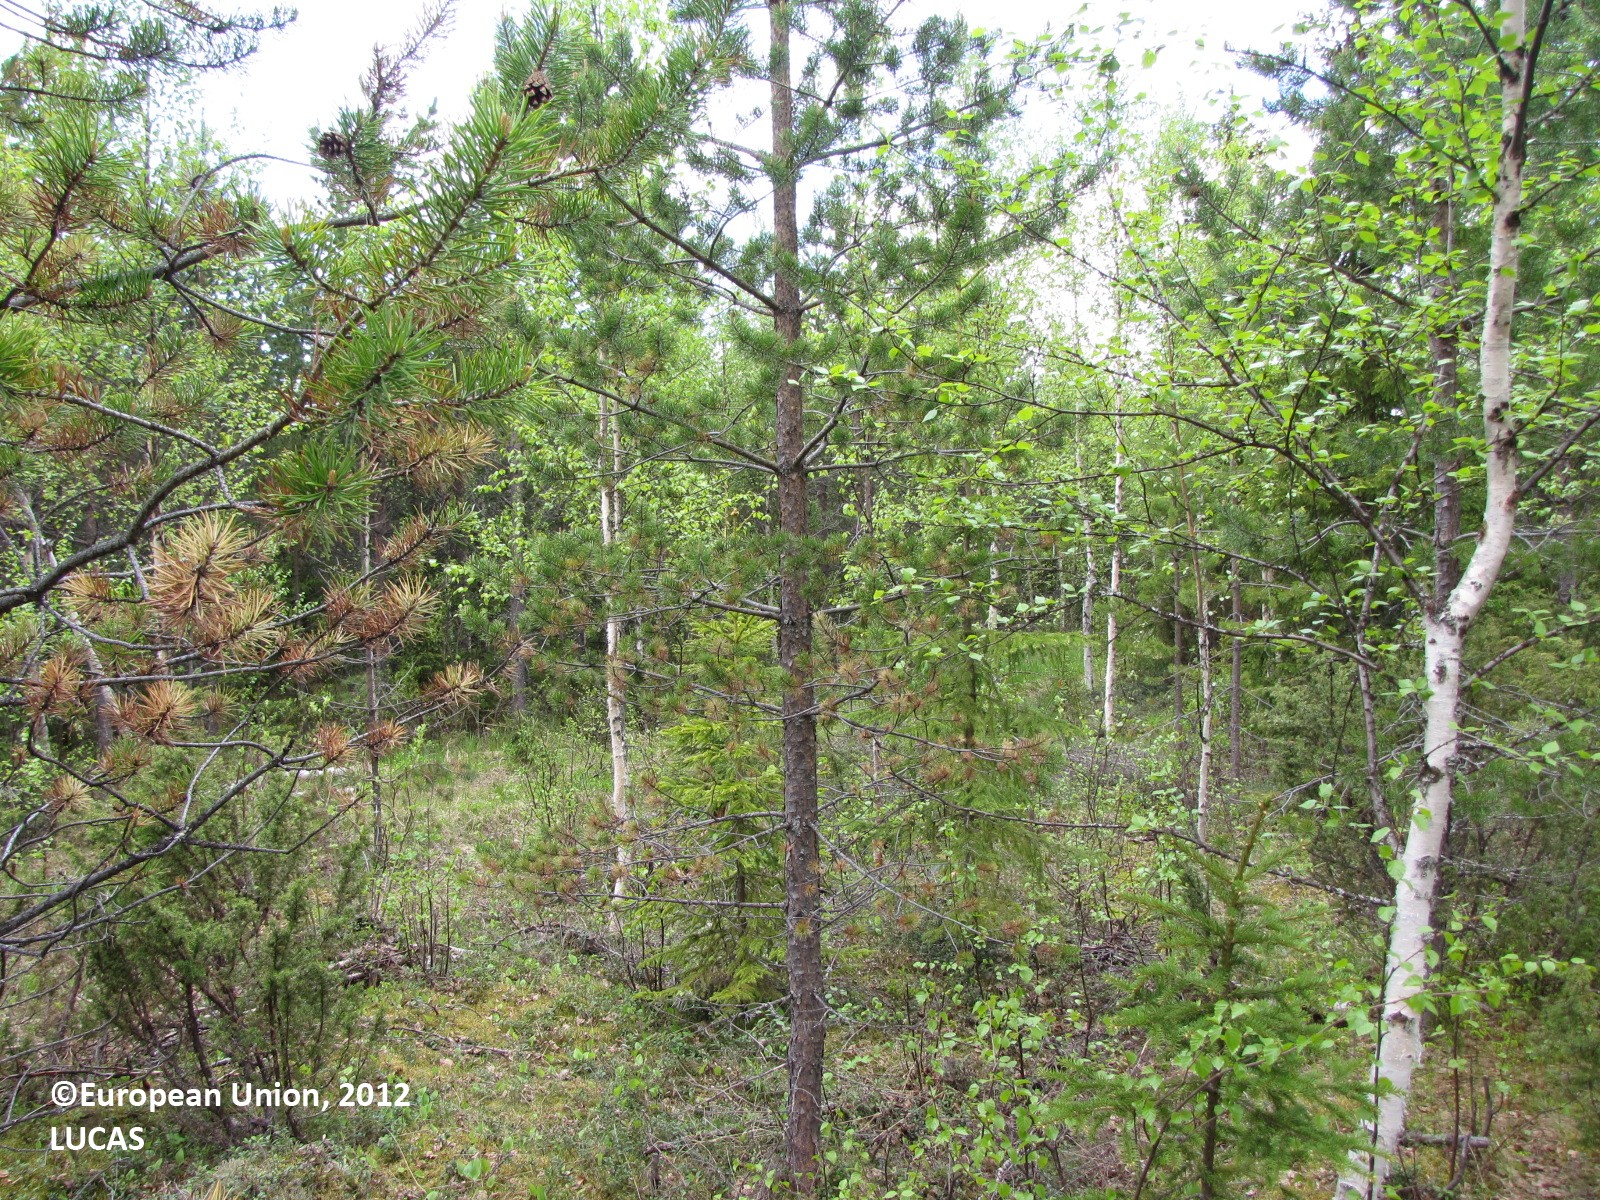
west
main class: Woodland
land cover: Other coniferous woodland
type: boreal forest
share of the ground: 25 - 50 %
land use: Forestry
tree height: > 5 m
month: June
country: FI
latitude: 65.8525
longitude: 24.6680
